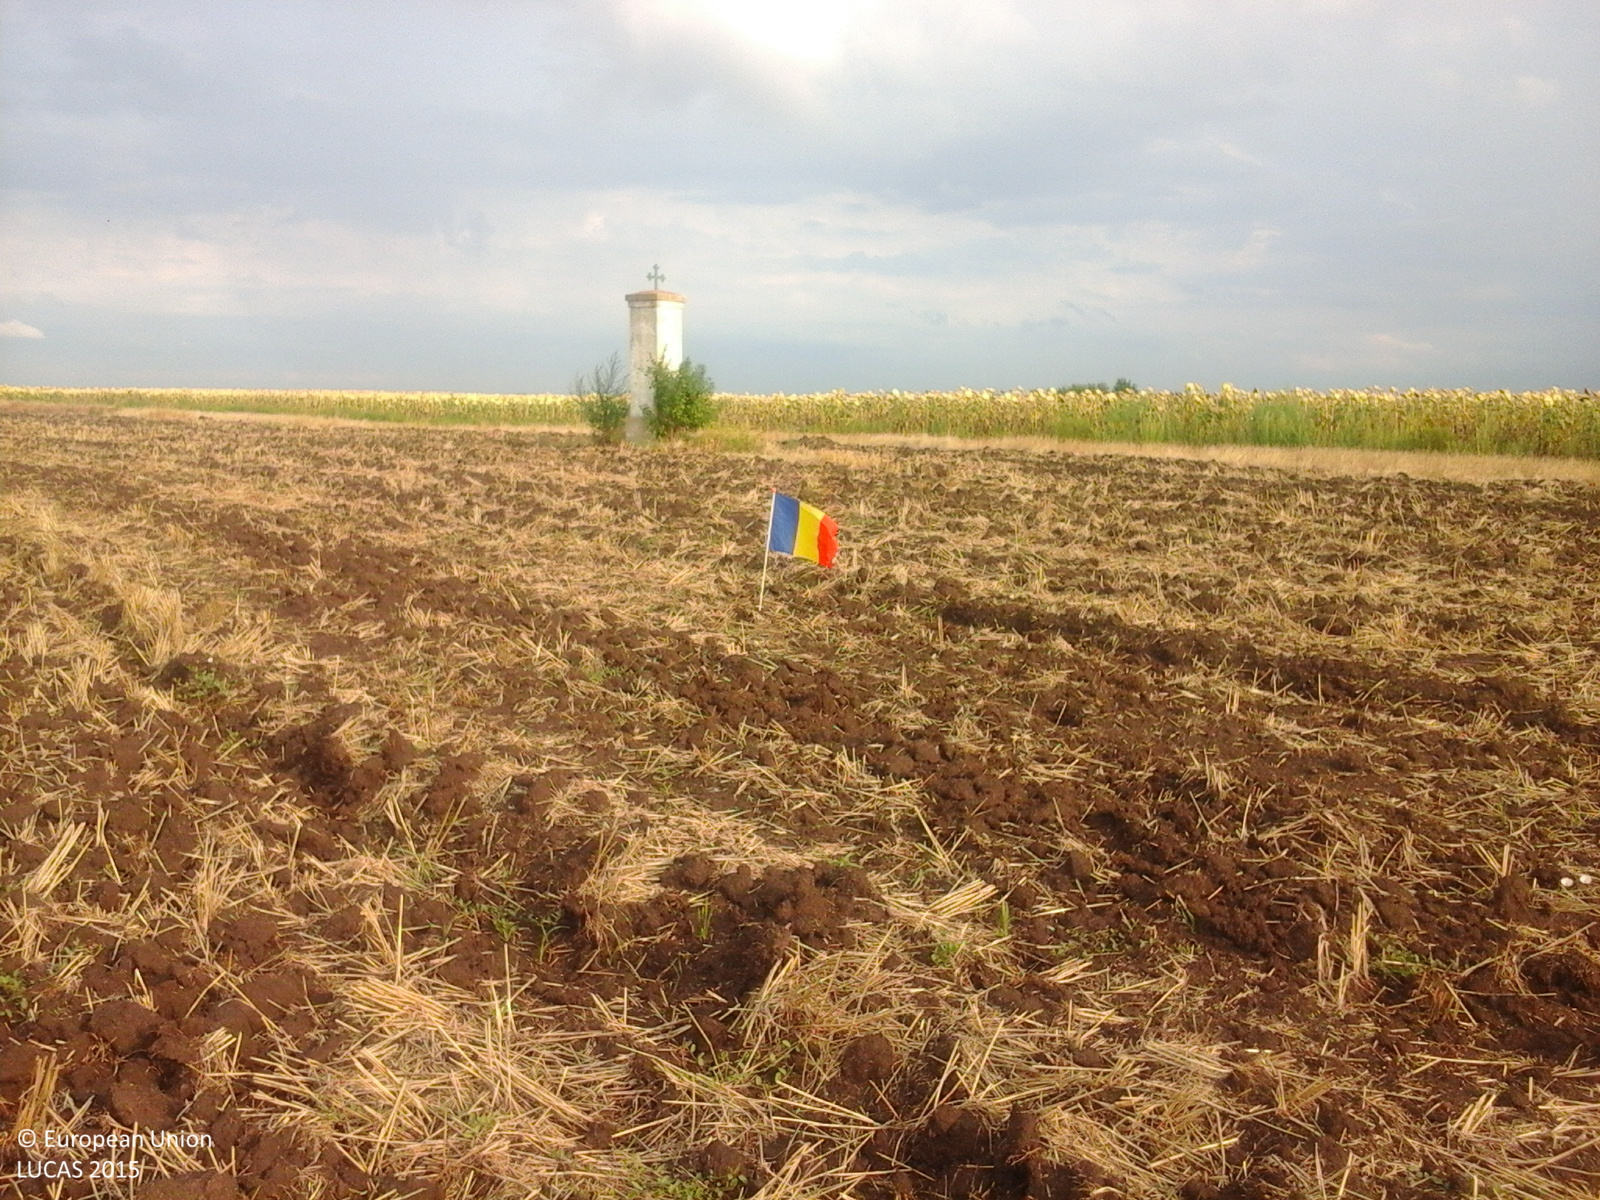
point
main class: Cropland
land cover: Common wheat
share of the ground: 25 - 50 %
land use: Agriculture (excluding fallow land and kitchen gardens)
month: August
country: RO
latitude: 45.8209
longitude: 21.3198
